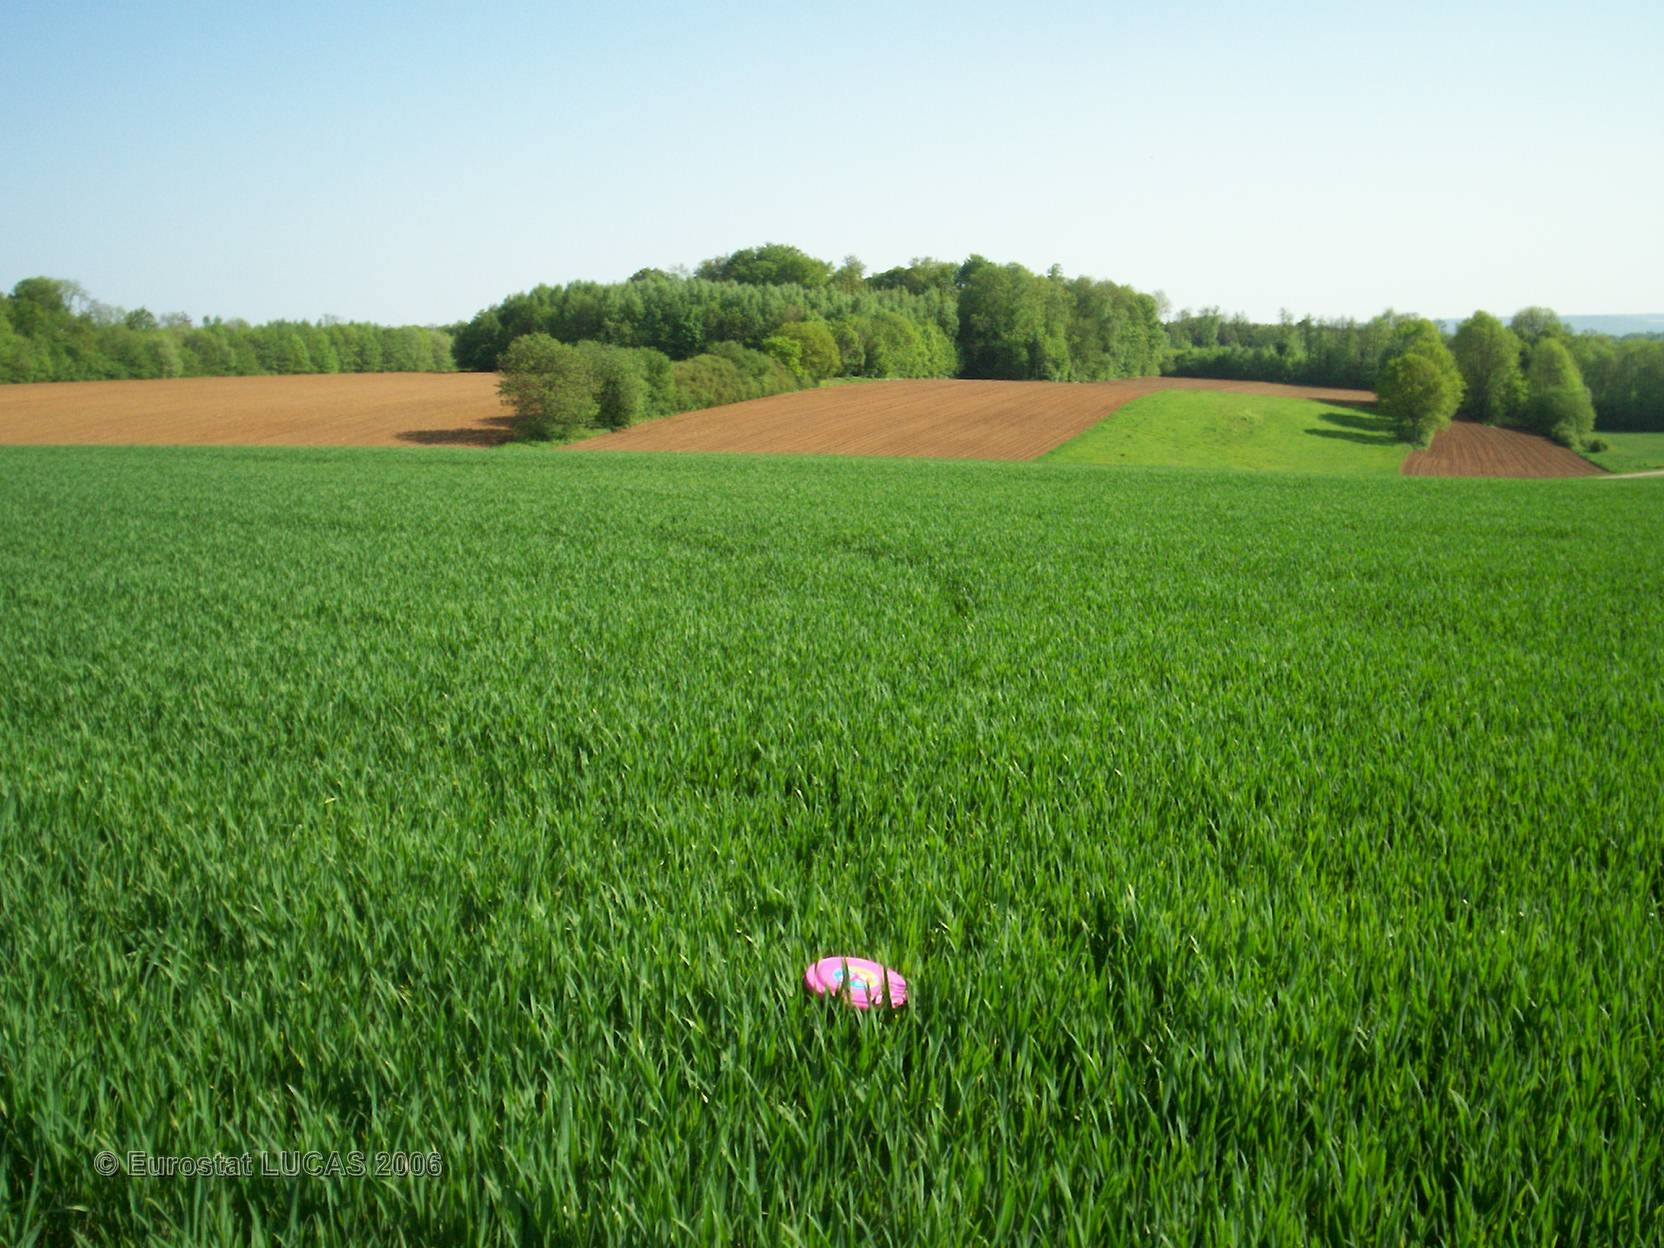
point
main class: Cropland
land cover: Common wheat
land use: Agriculture (excluding fallow land and kitchen gardens)
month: May
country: FR
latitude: 49.7151
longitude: 5.0185
